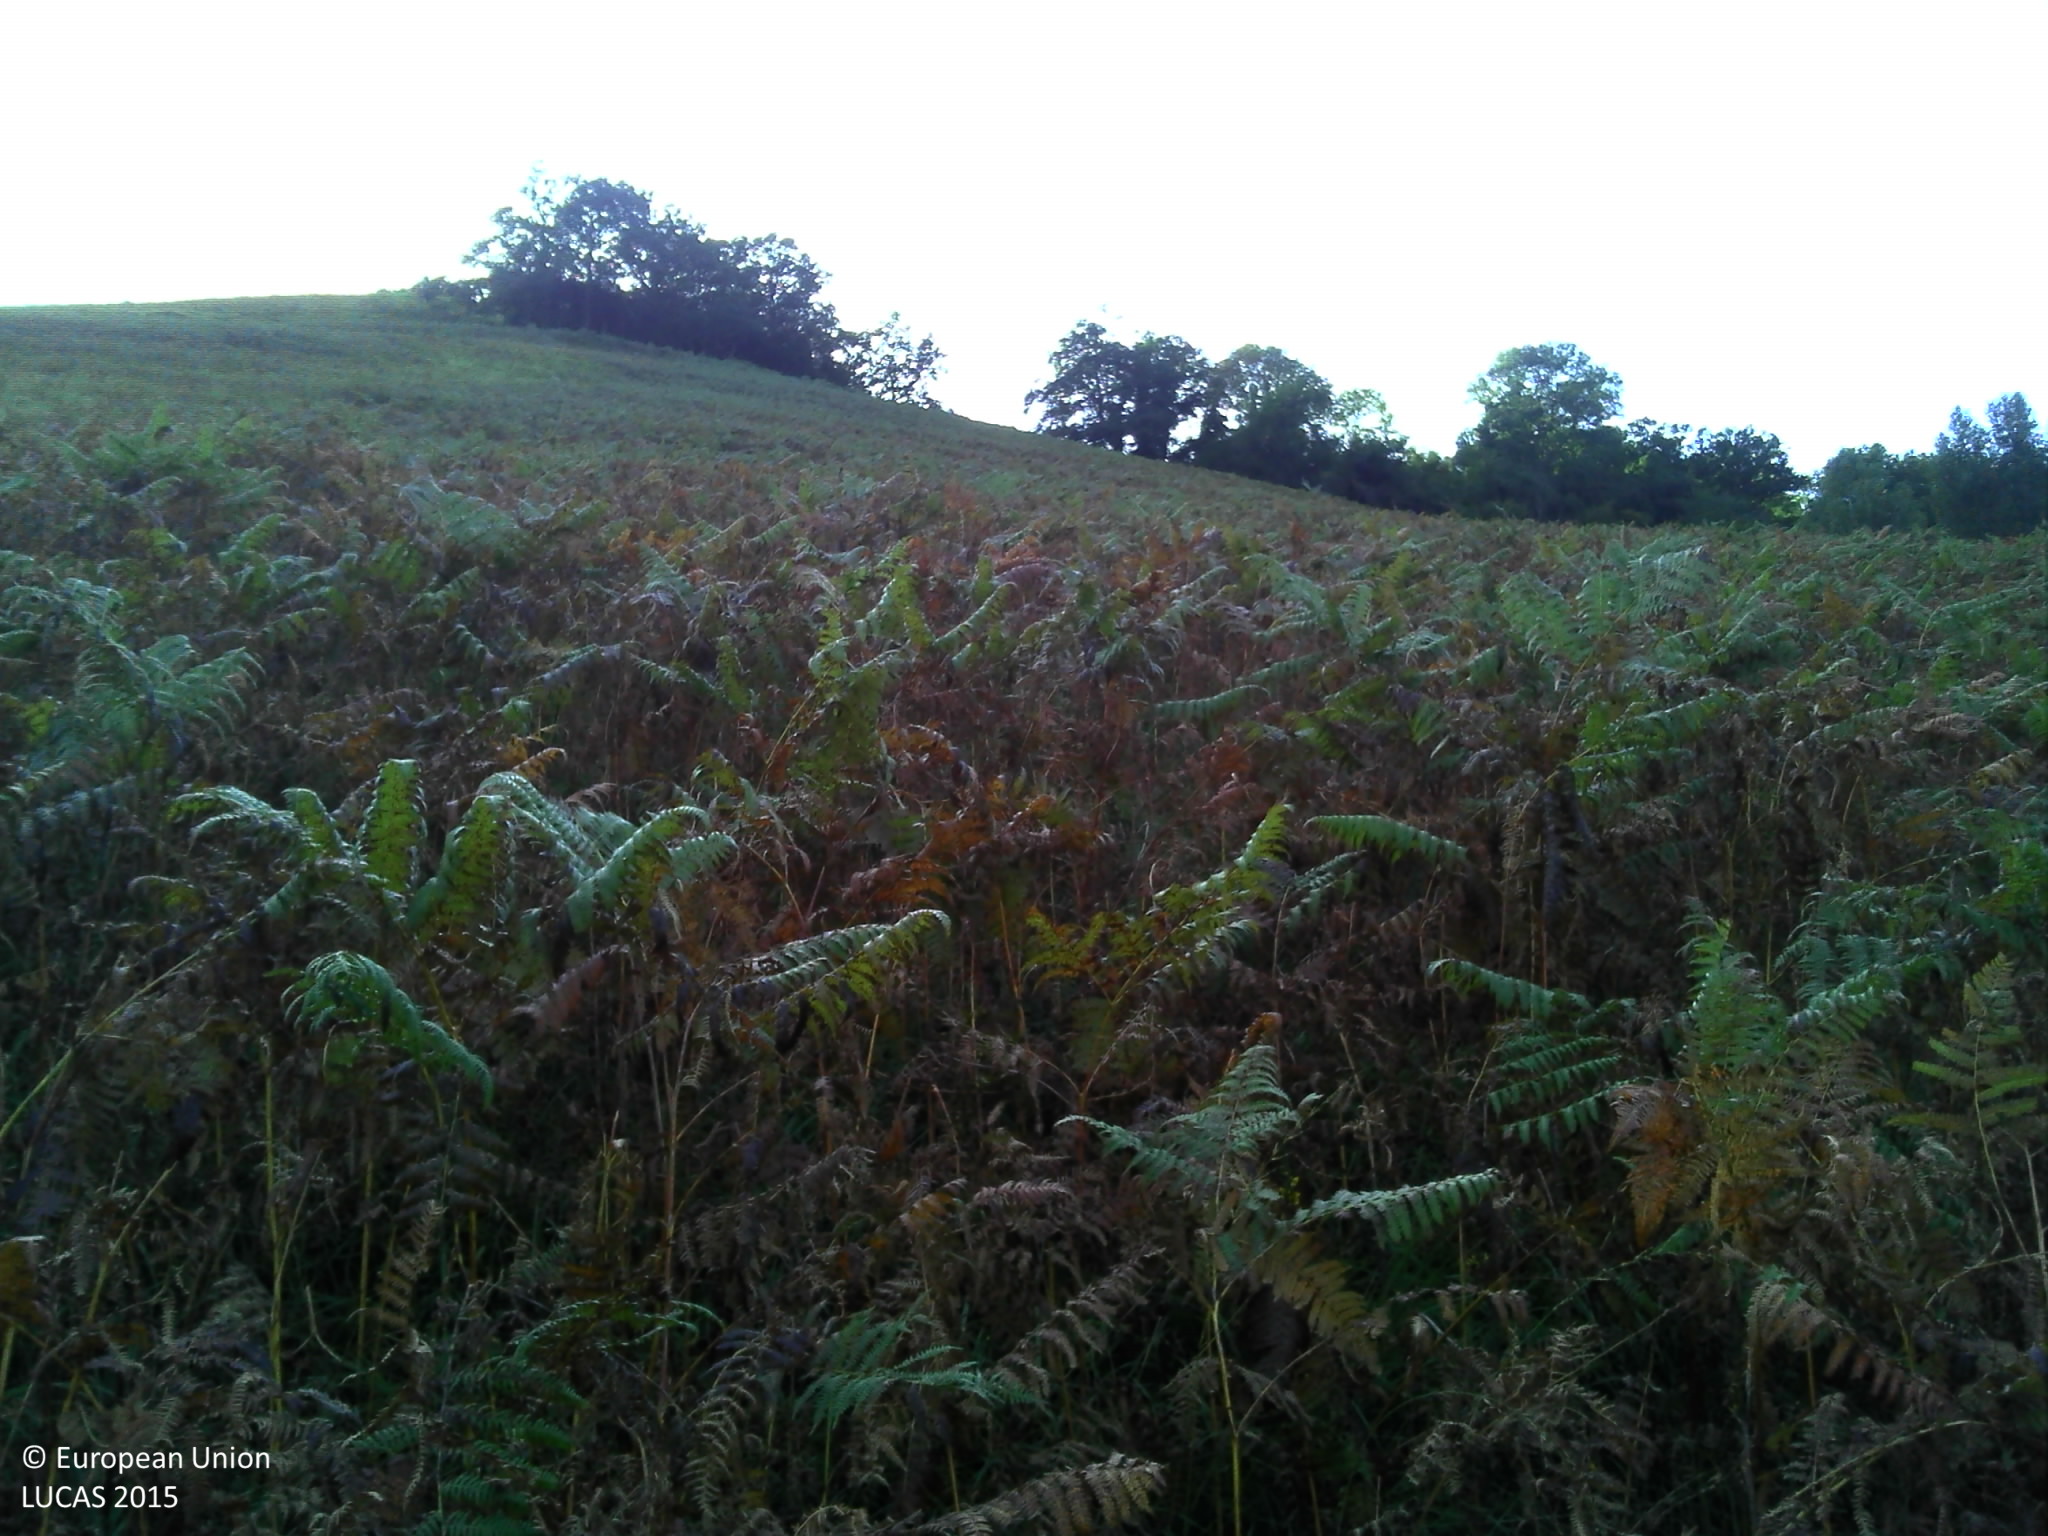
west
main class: Grassland
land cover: Grassland without tree/shrub cover
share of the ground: > 75 %
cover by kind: herbaceous plants 95 %, shrubs 5 %
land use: Agriculture (excluding fallow land and kitchen gardens)
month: September
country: FR
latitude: 43.0041
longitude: -0.6181
